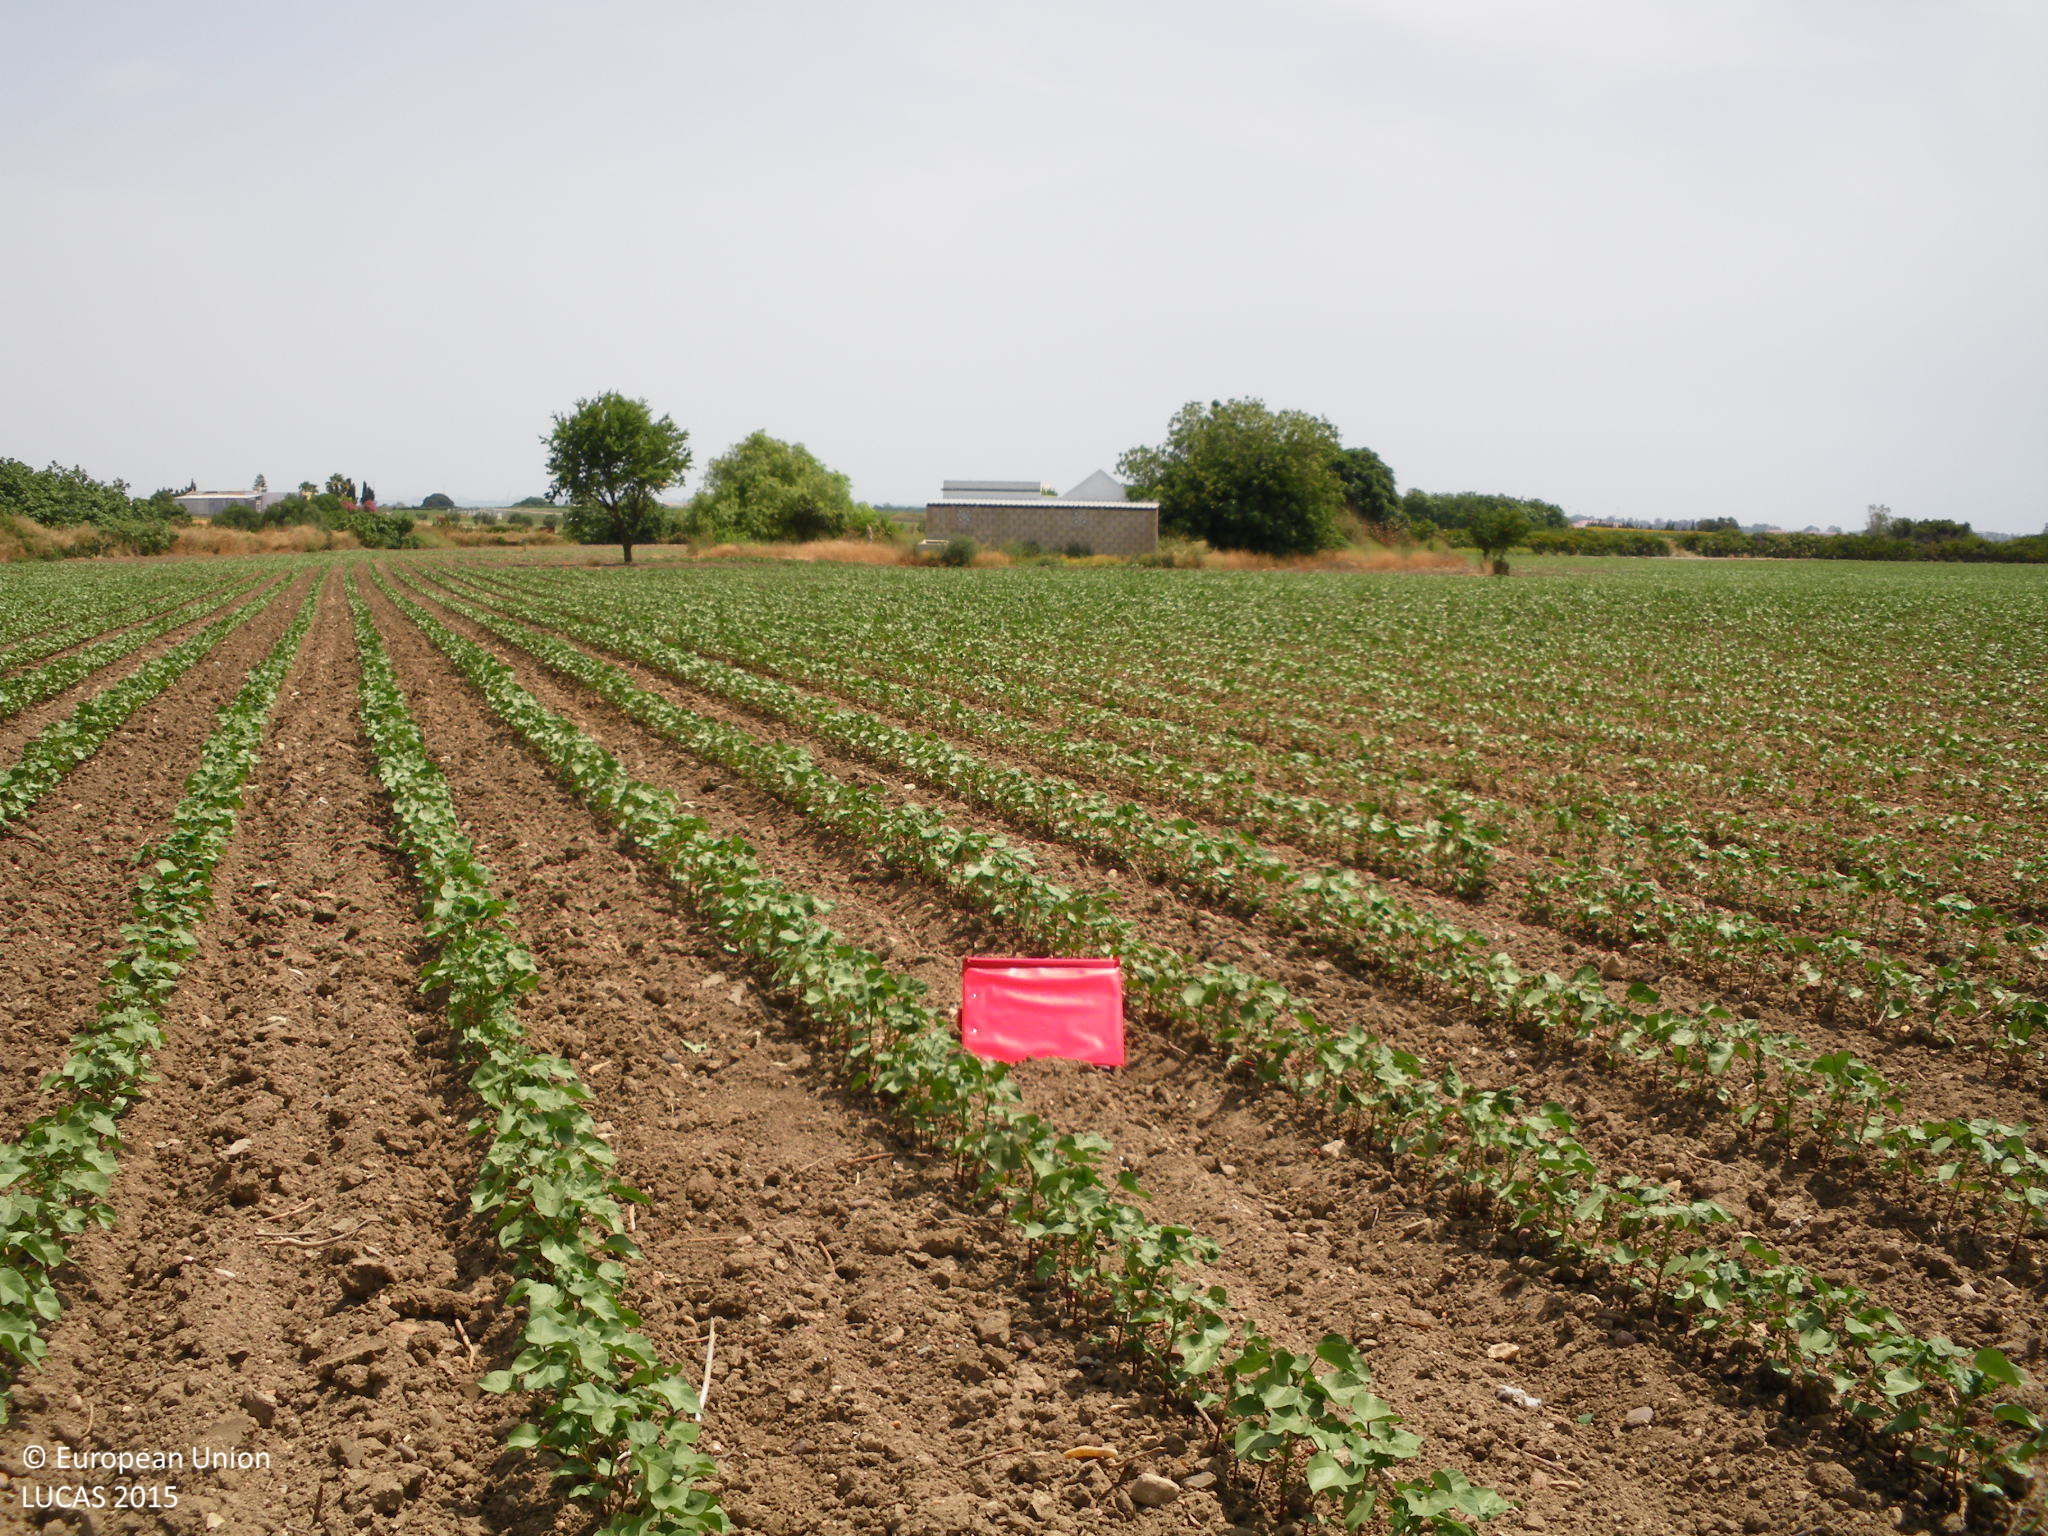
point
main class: Cropland
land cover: Cotton
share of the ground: 10 - 25 %
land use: Agriculture (excluding fallow land and kitchen gardens)
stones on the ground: < 10 %
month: June
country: ES
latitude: 36.6744
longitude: -6.3408
